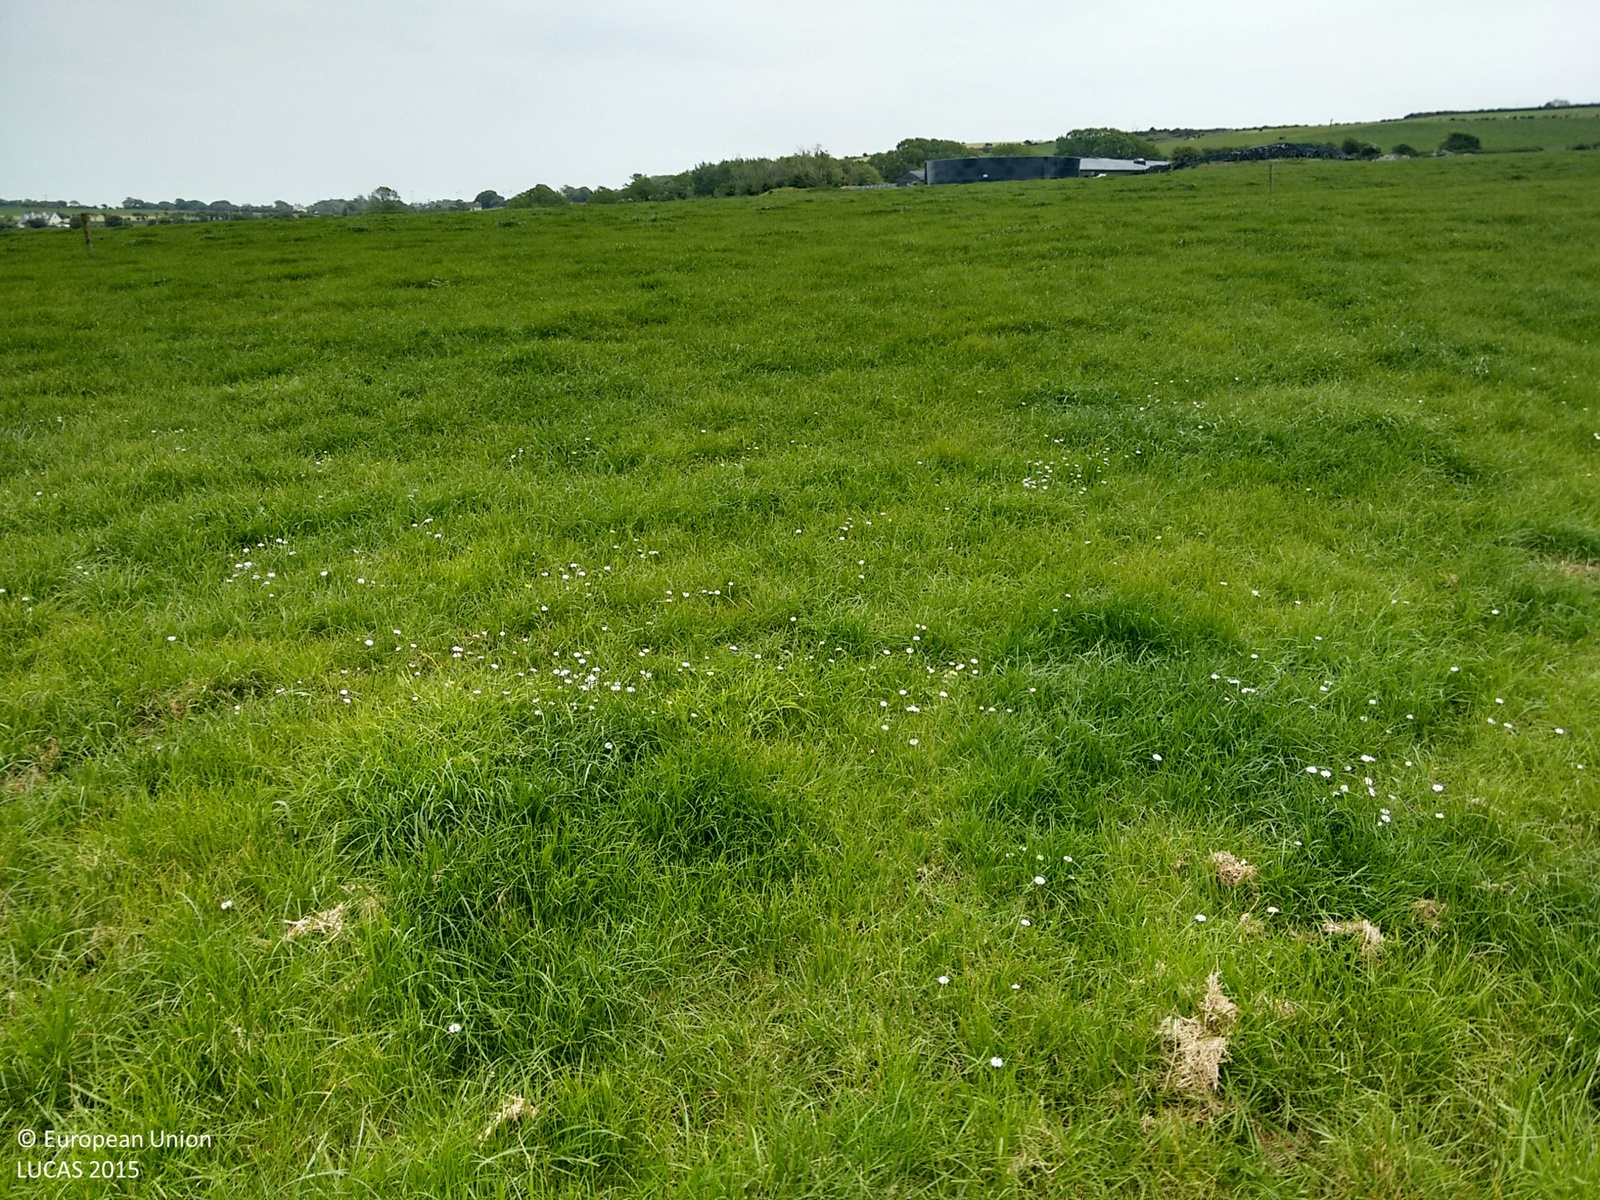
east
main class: Grassland
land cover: Grassland without tree/shrub cover
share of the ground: > 75 %
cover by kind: herbaceous plants 95 %, shrubs 5 %
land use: Agriculture (excluding fallow land and kitchen gardens)
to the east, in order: Grassland without tree/shrub cover; Fences; Grass margins; Abandoned hedges; Grass margins; Fences; Grassland without tree/shrub cover; Fences; Grassland without tree/shrub cover; Fences; Grassland without tree/shrub cover; Artificial constructions in urban areas
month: June
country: IE
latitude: 51.6017
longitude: -8.7559
